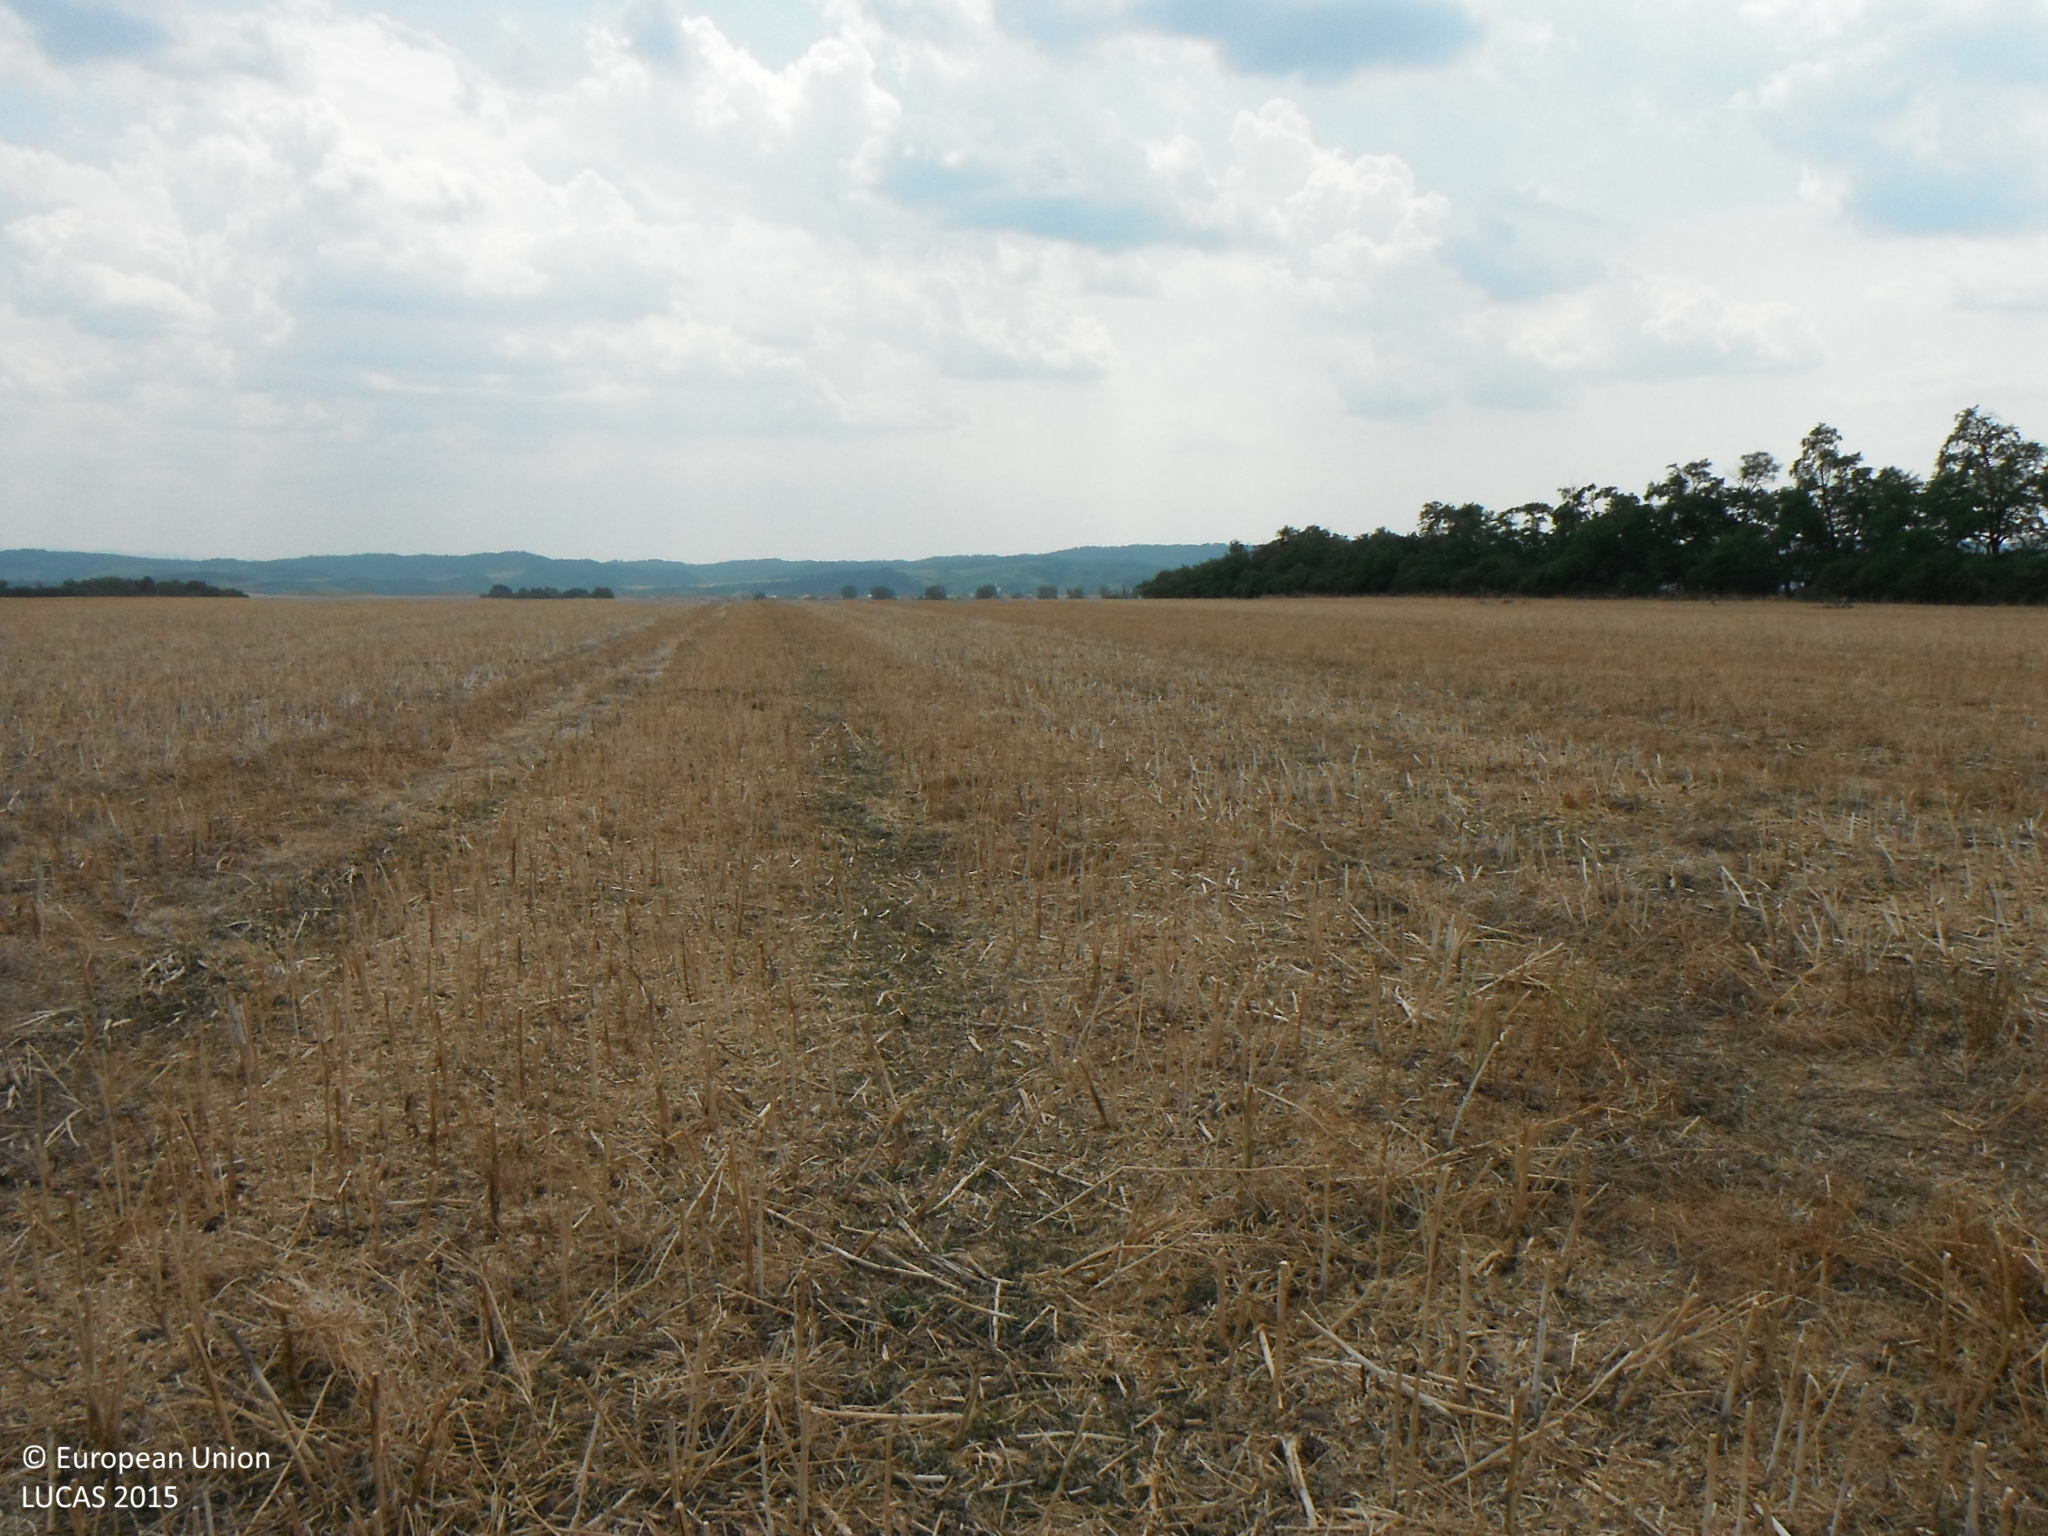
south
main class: Cropland
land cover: Rape and turnip rape
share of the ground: > 75 %
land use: Agriculture (excluding fallow land and kitchen gardens)
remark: Harvested field
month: July
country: SK
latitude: 48.3128
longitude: 20.1844
